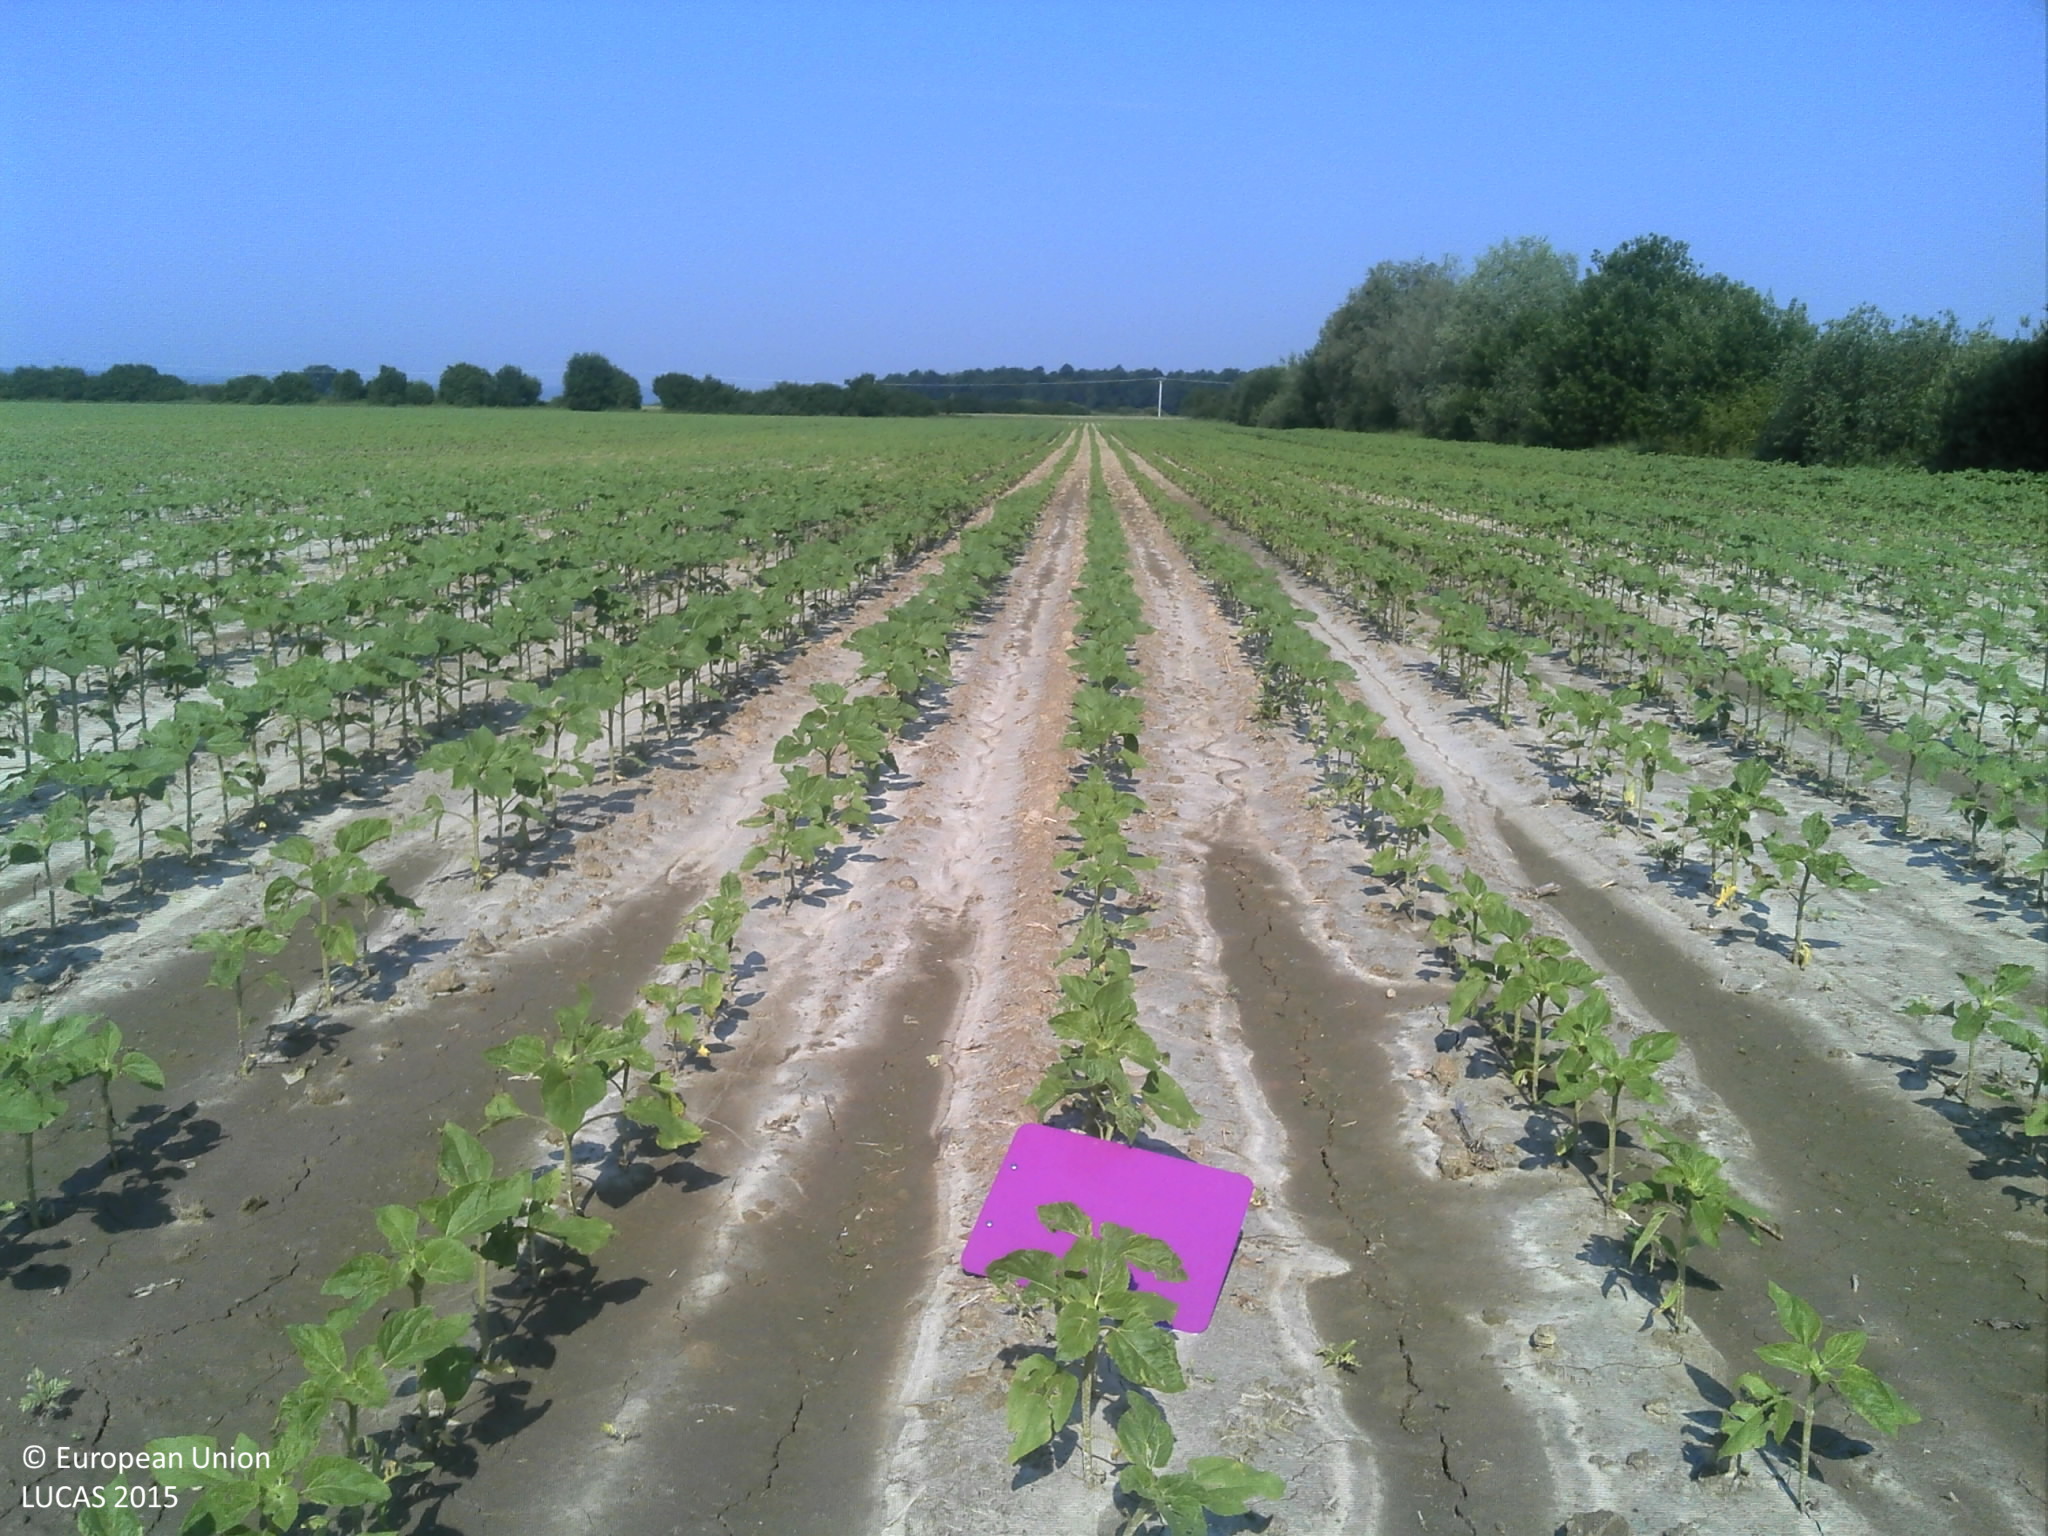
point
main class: Cropland
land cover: Soya
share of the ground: 10 - 25 %
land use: Agriculture (excluding fallow land and kitchen gardens)
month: June
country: HR
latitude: 45.6825
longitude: 17.8485
